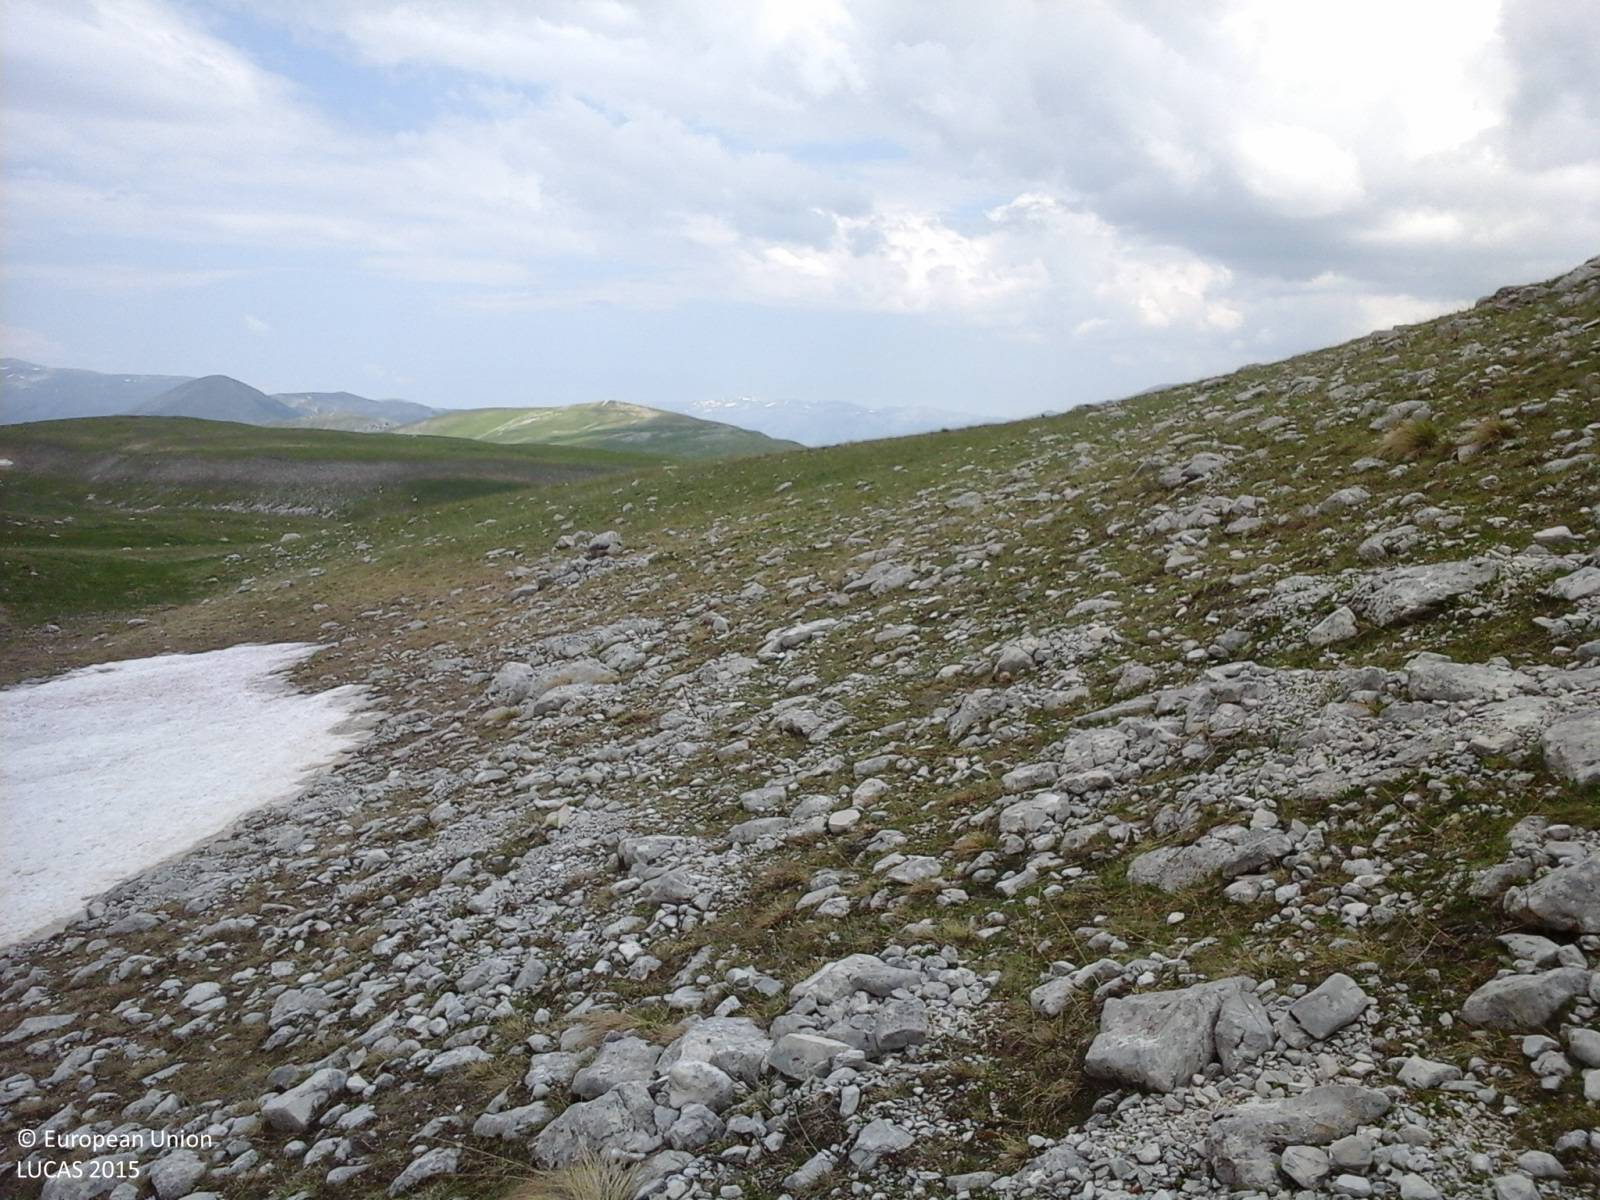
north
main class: Grassland
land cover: Grassland without tree/shrub cover
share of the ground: > 75 %
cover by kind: herbaceous plants 85 %, unconsolidated bare surface 10 %
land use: Agriculture (excluding fallow land and kitchen gardens)
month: June
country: IT
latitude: 41.8165
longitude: 13.9708
